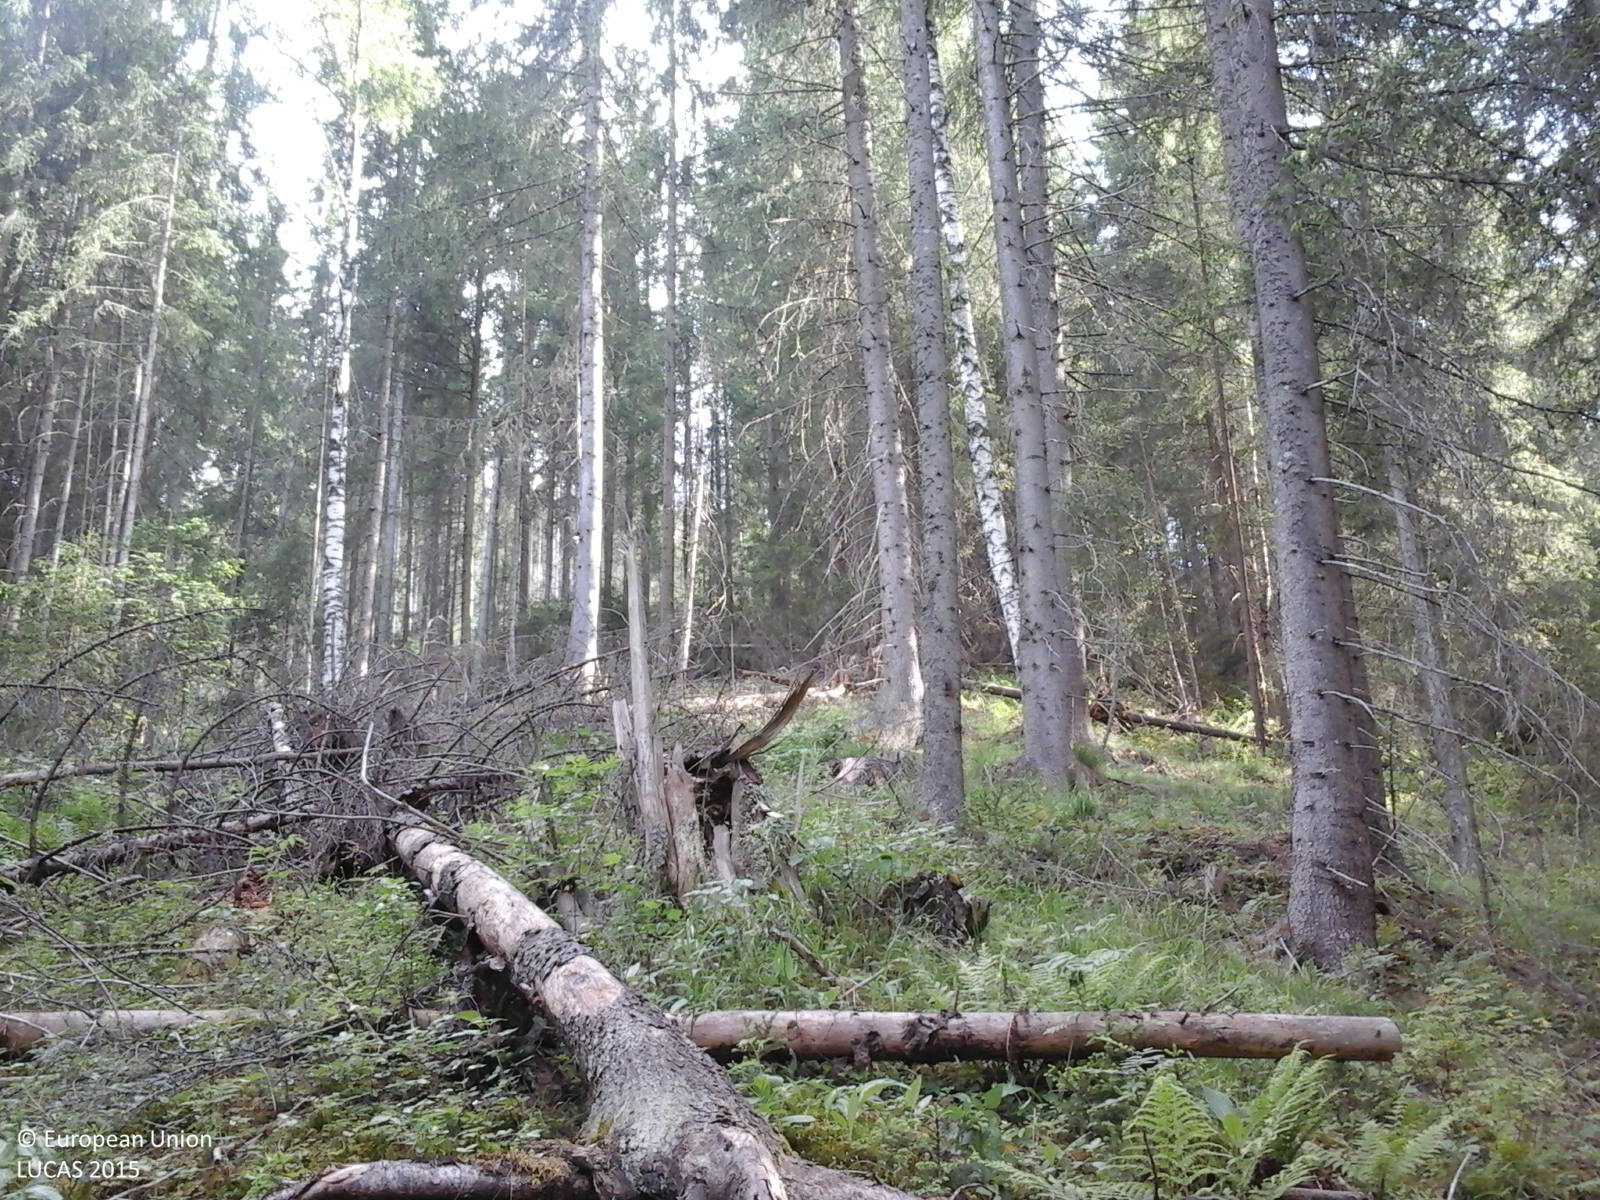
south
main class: Woodland
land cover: Spruce dominated coniferous woodland
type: alpine coniferous forest
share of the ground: > 75 %
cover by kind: coniferous forest trees 100 %
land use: Forestry
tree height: > 5 m
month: June
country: RO
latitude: 47.1895
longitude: 25.5161
